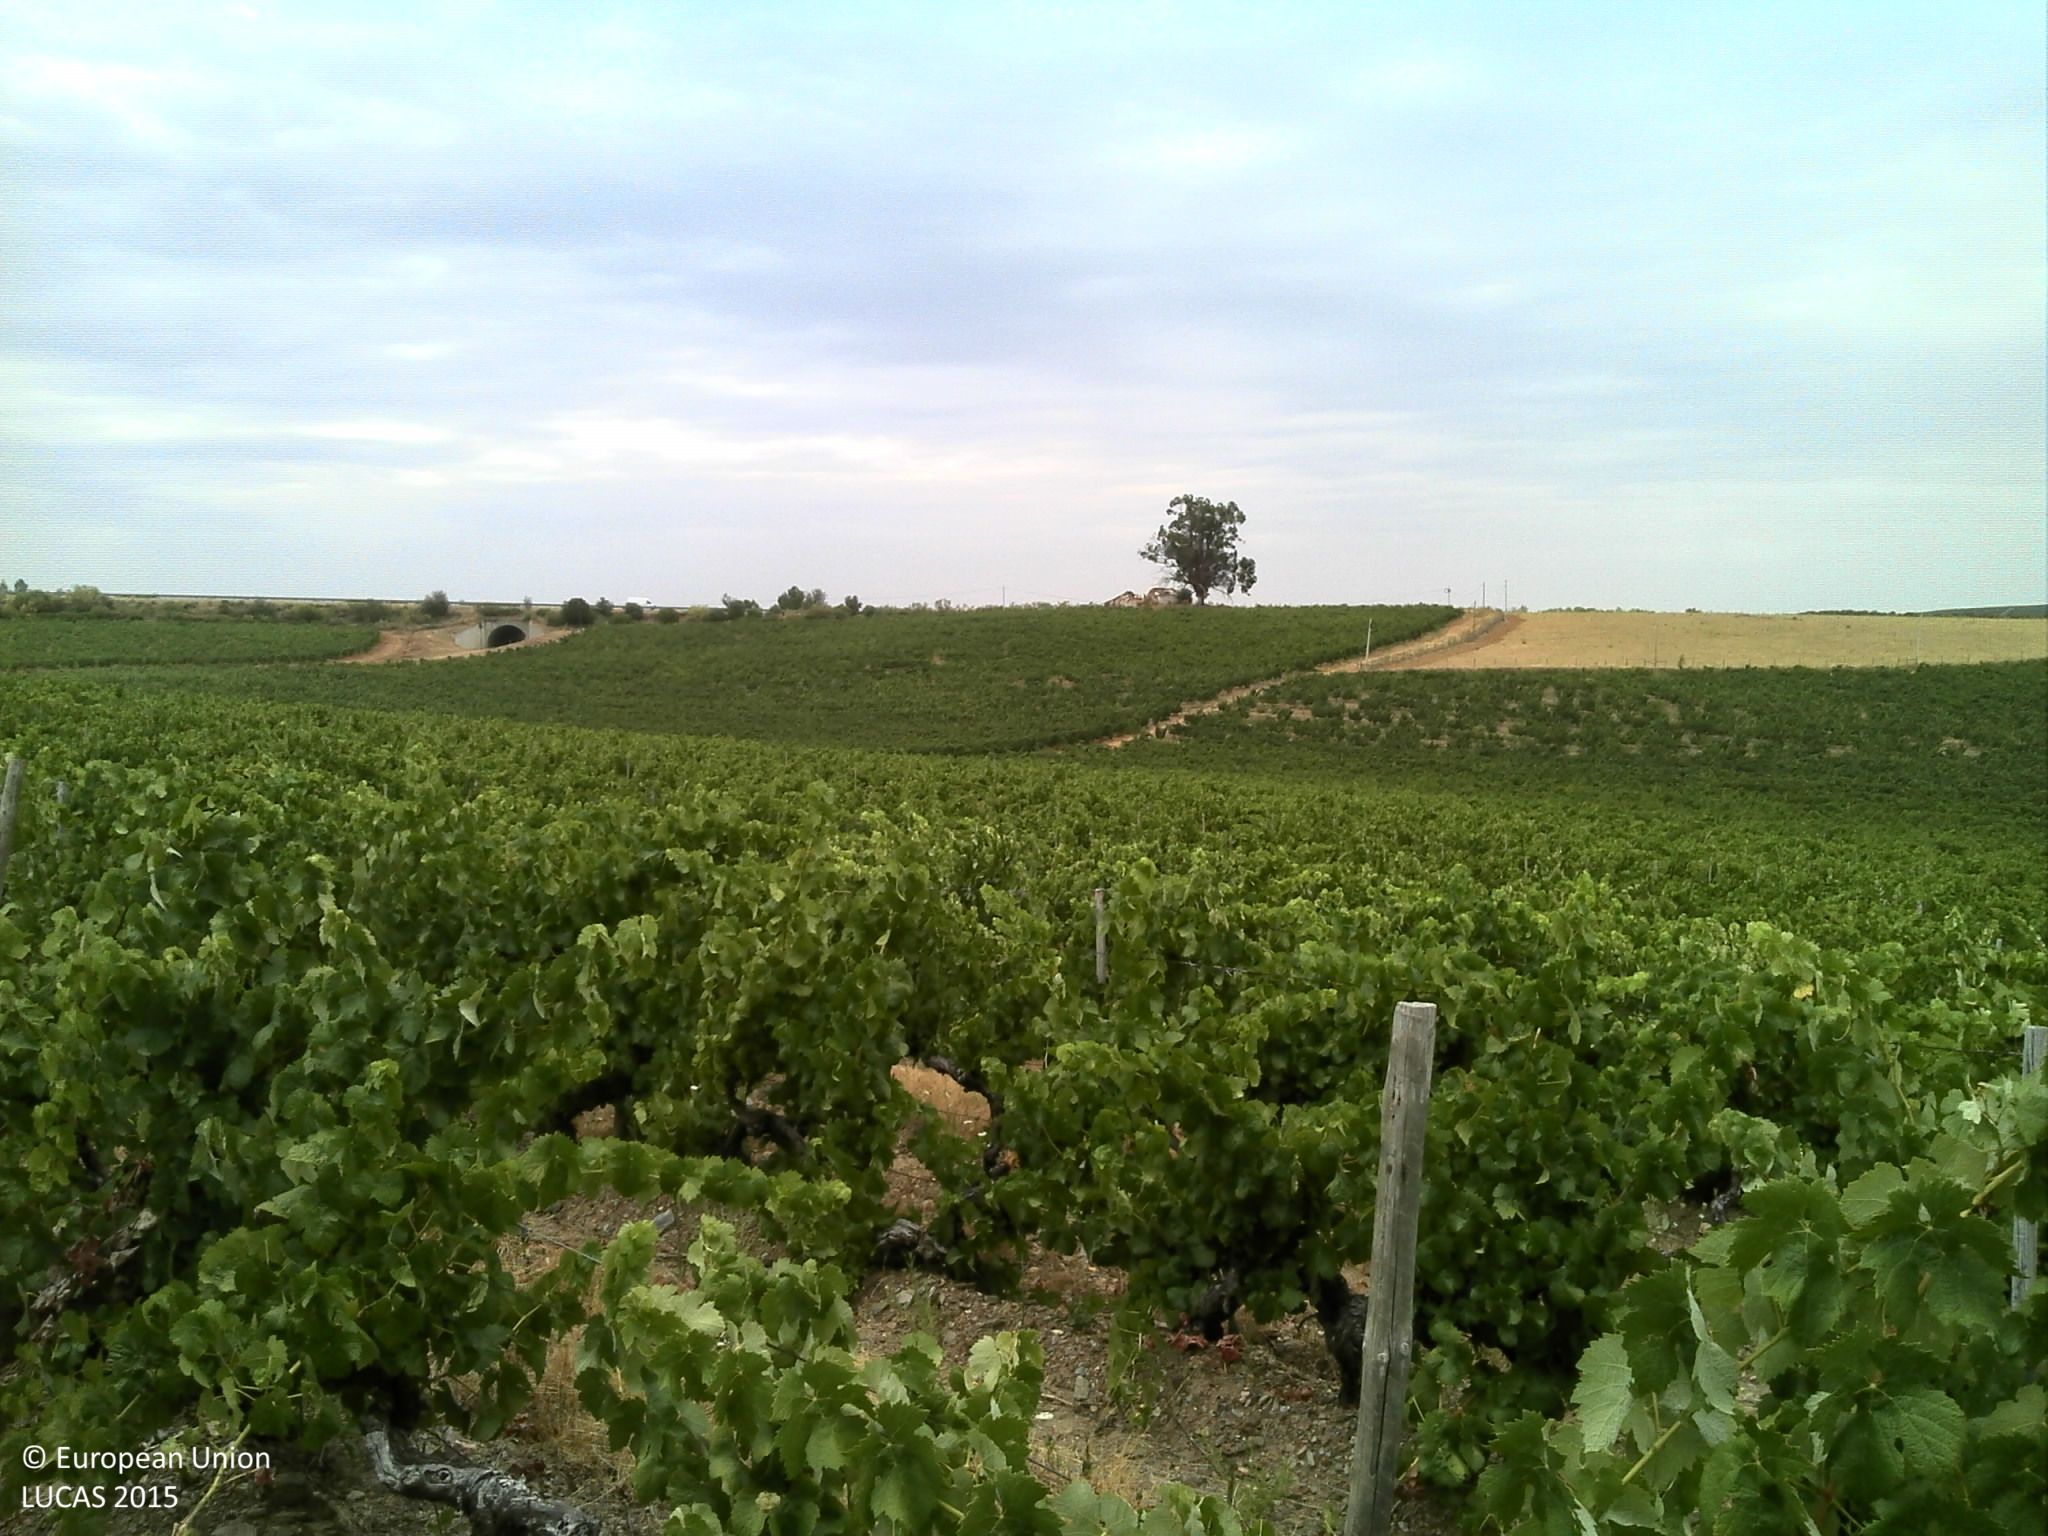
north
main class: Cropland
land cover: Vineyards
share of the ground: 25 - 50 %
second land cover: Other bare soil
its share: > 75 %
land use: Agriculture (excluding fallow land and kitchen gardens)
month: July
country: PT
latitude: 38.8215
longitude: -7.4364
